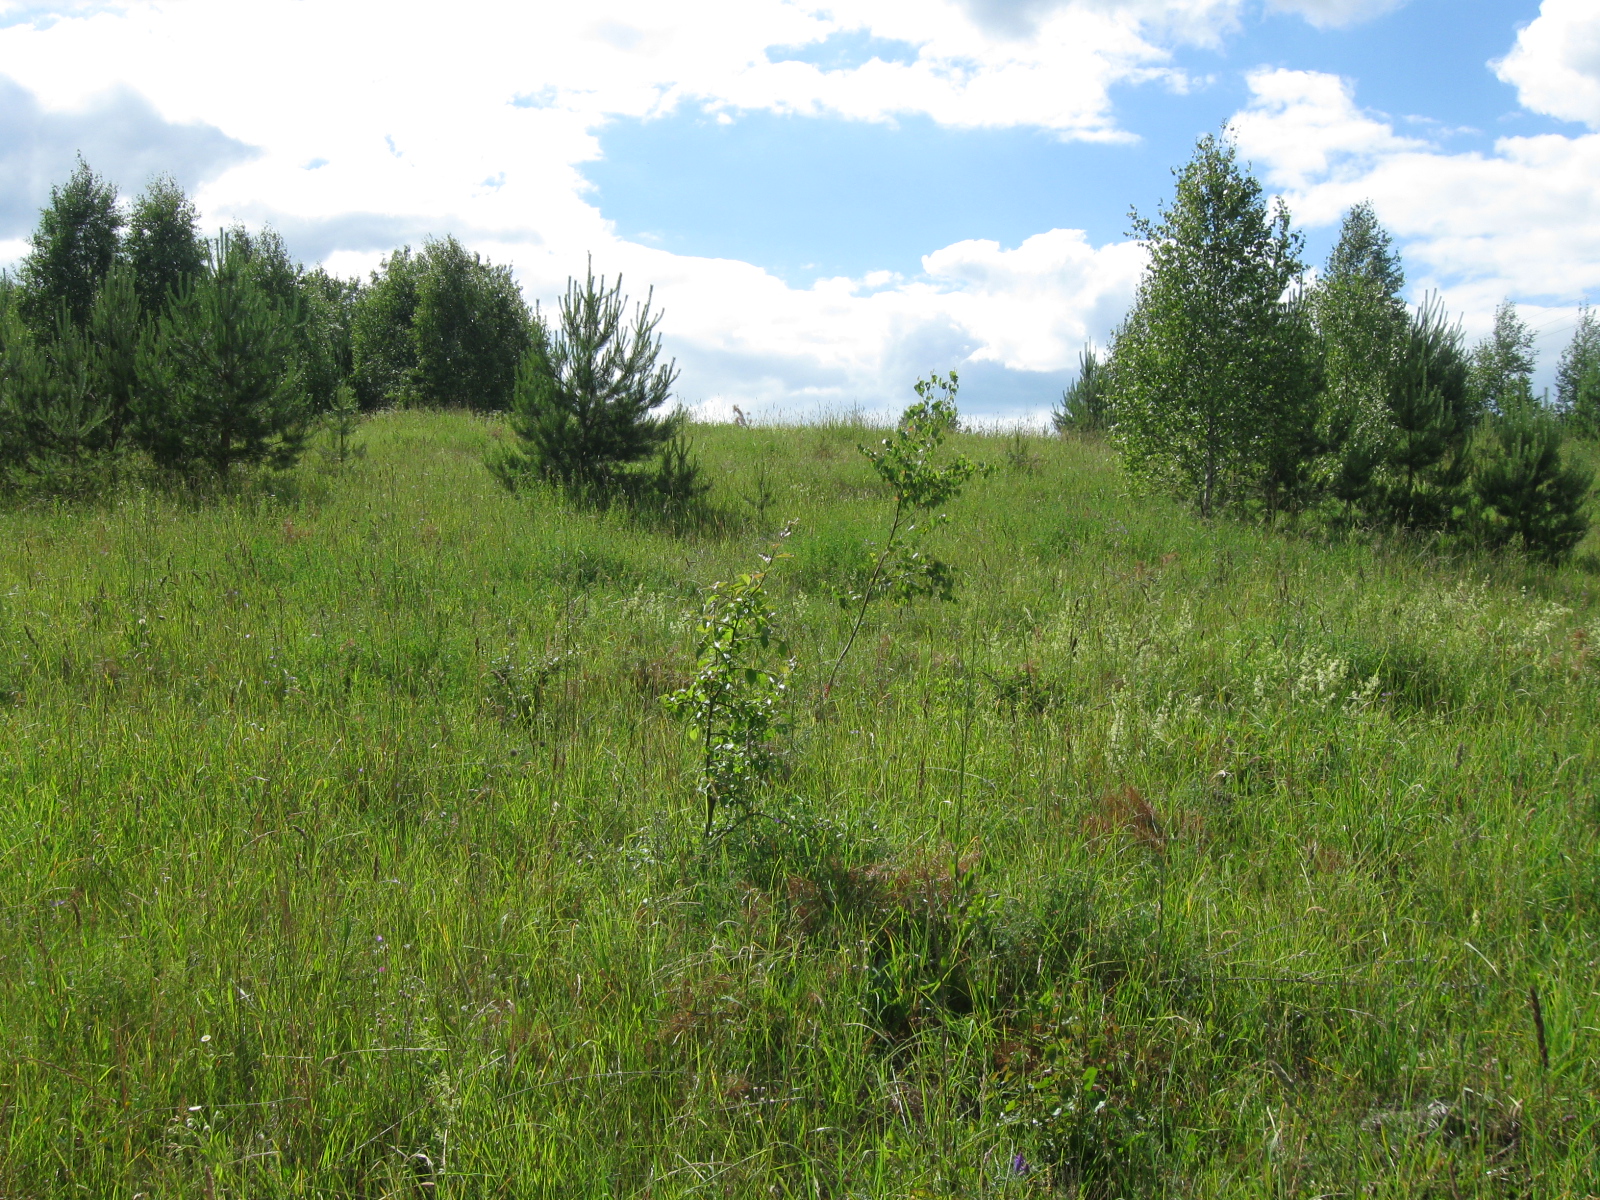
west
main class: Grassland
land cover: Grassland with sparse tree/shrub cover
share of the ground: > 75 %
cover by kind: herbaceous plants 95 %, broadleaved forest trees 5 %
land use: Agriculture (excluding fallow land and kitchen gardens)
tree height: < 5 m
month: June
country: LT
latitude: 54.4964
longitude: 24.6668
